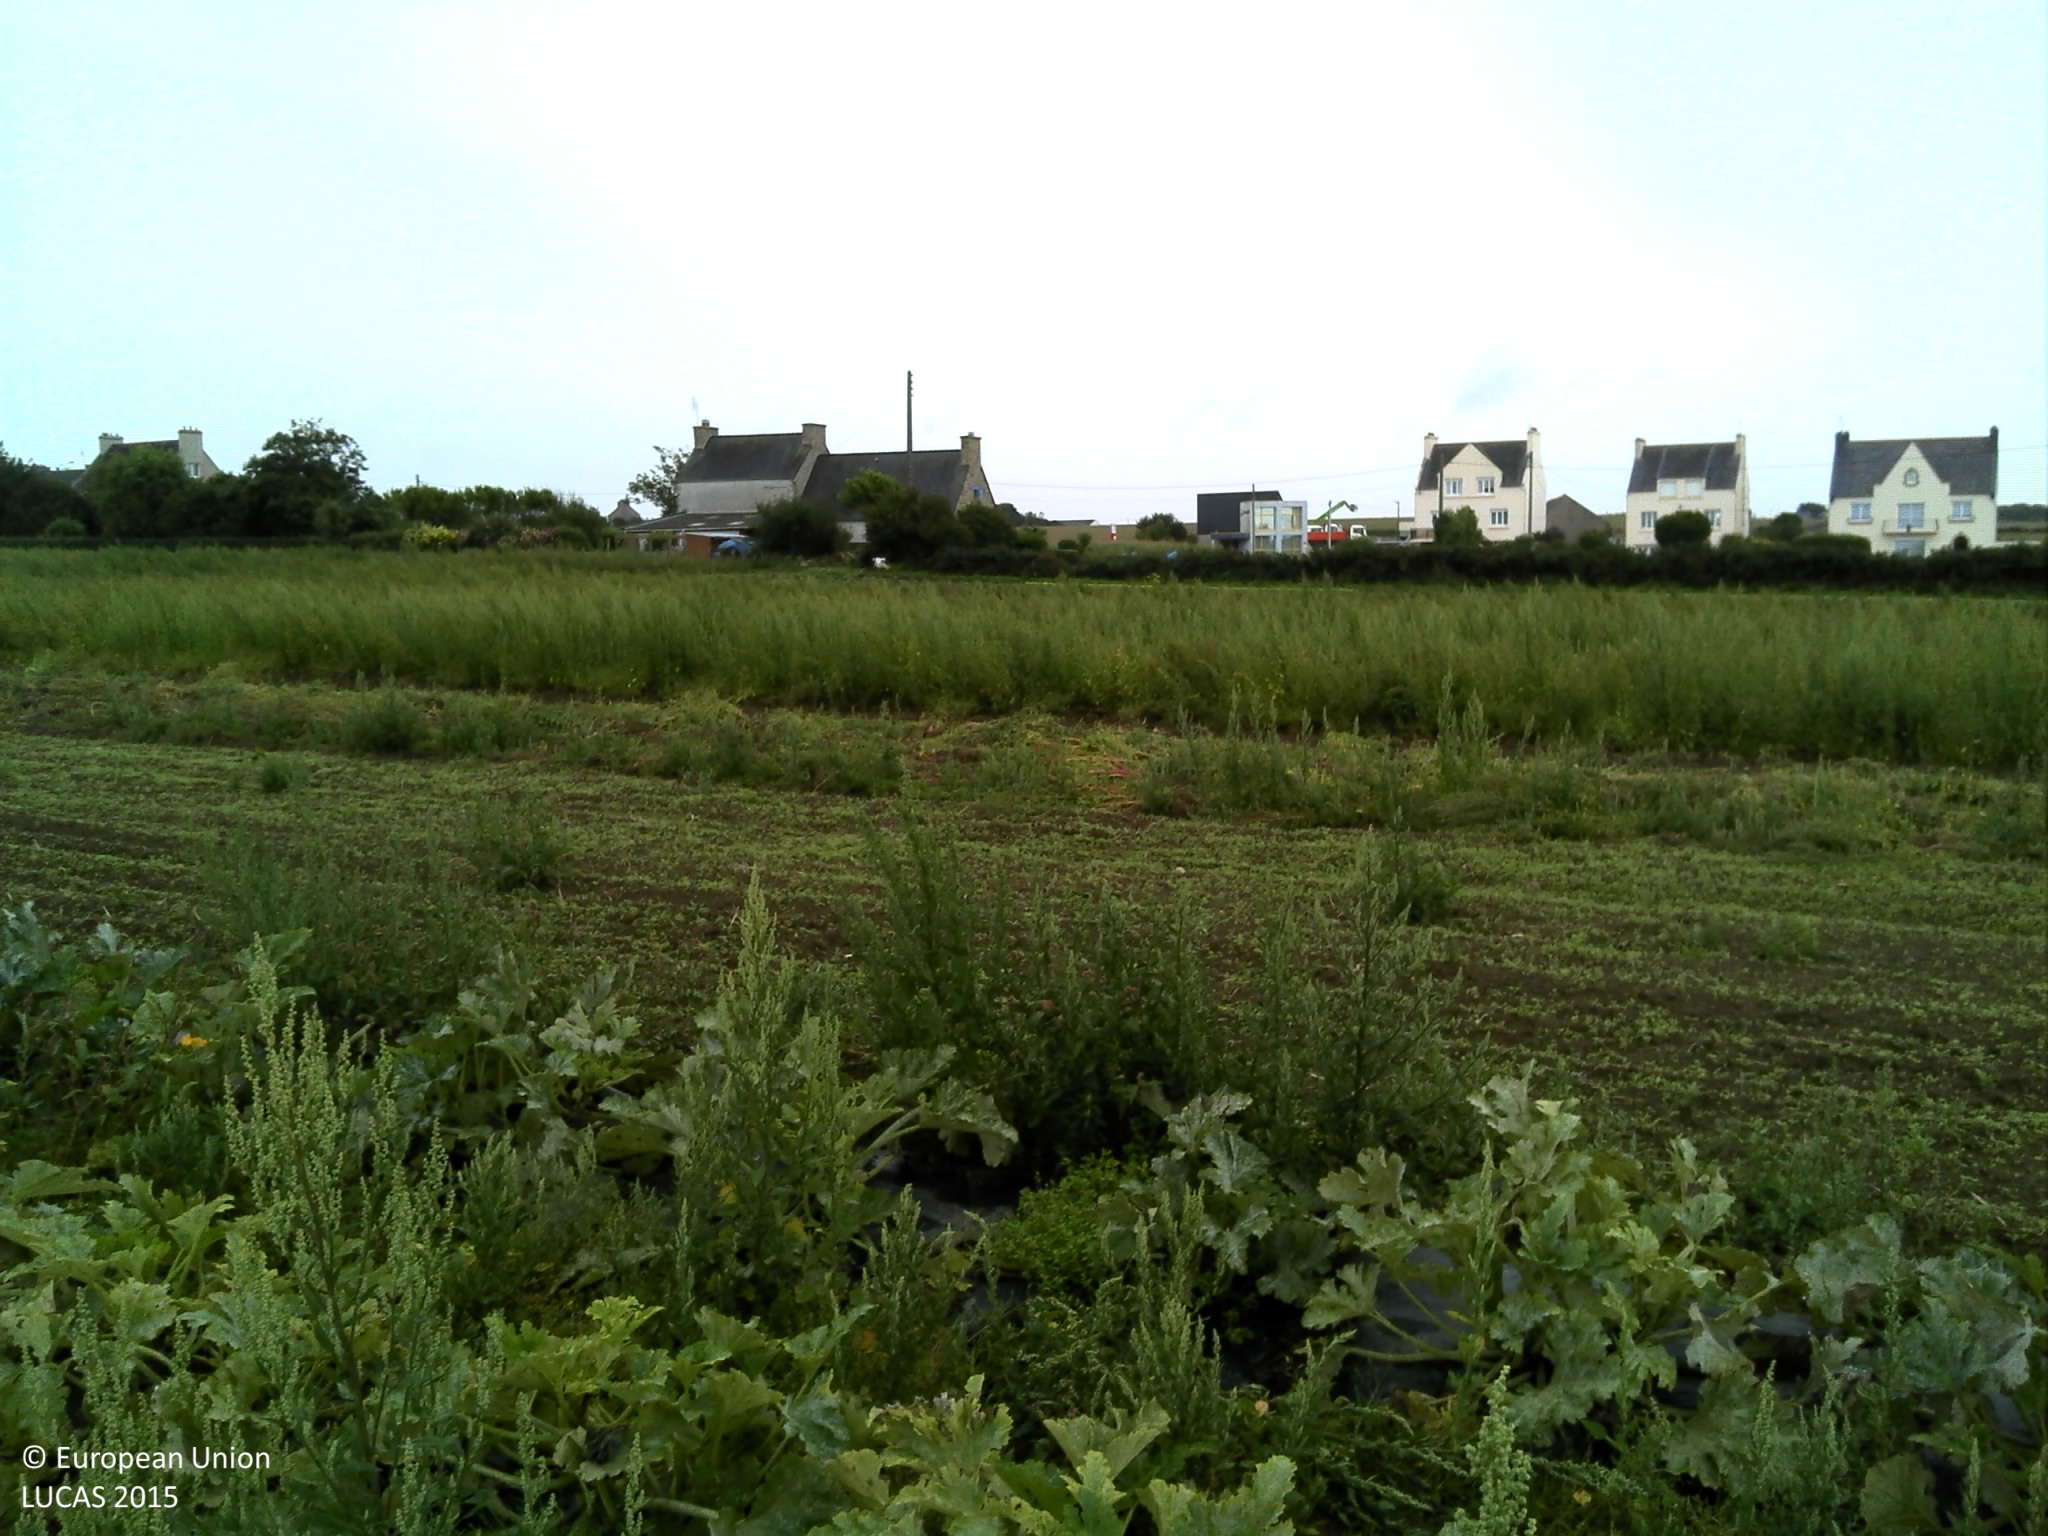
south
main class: Cropland
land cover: Other fresh vegetables
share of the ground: 50 - 75 %
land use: Agriculture (excluding fallow land and kitchen gardens)
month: August
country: FR
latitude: 48.6088
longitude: -4.5172
